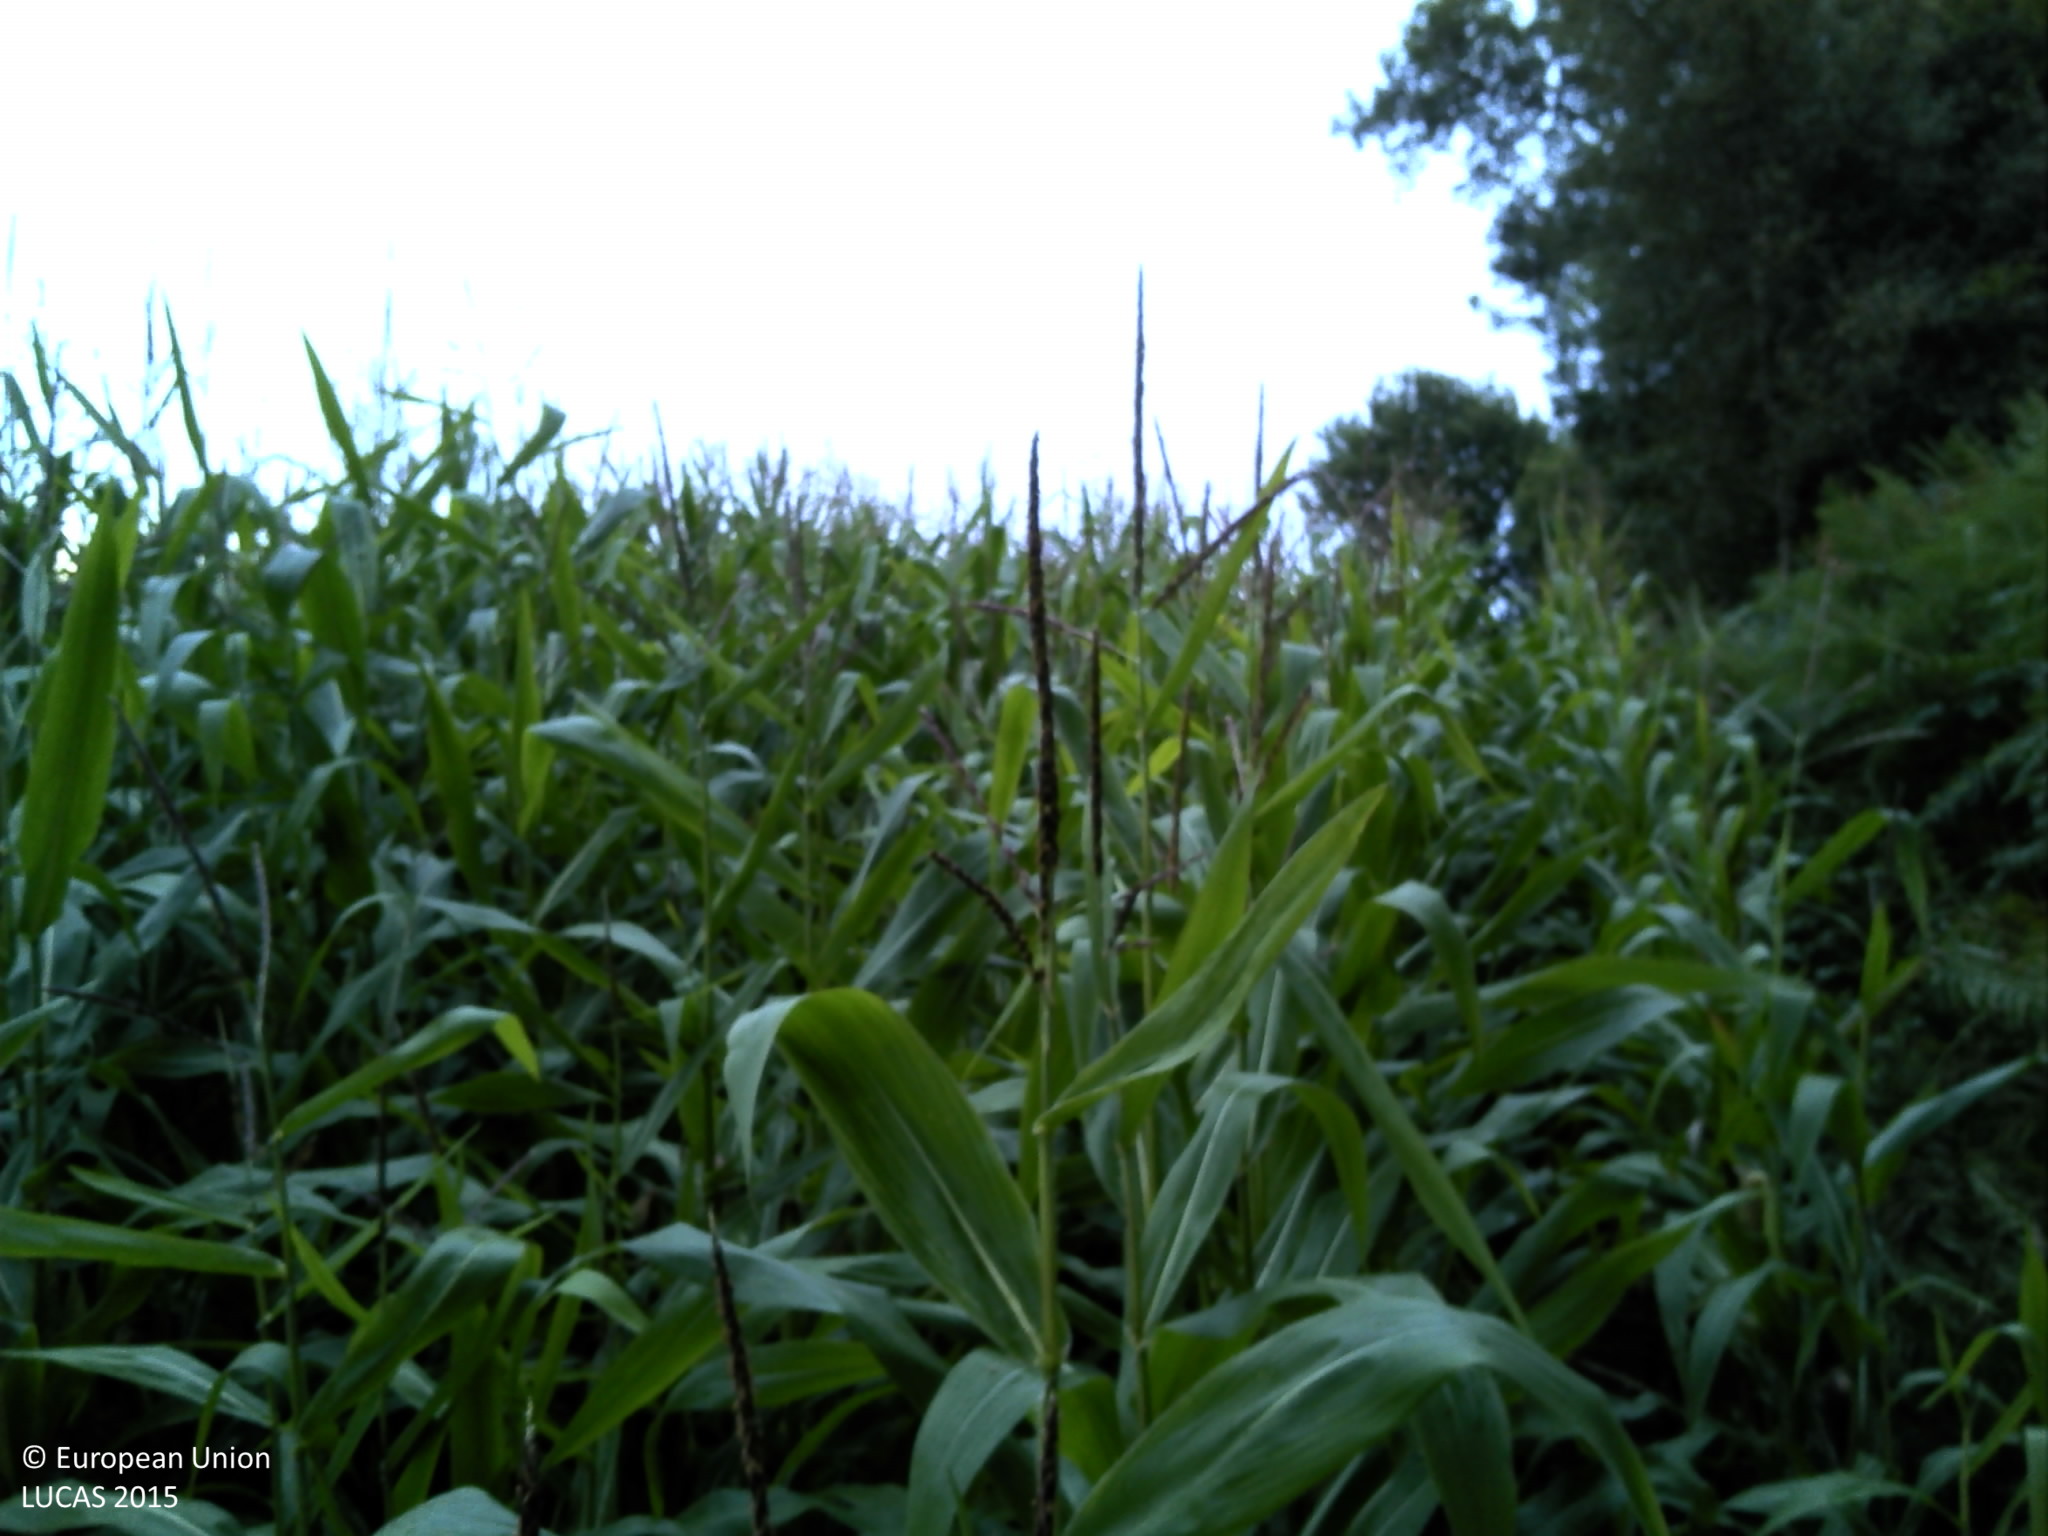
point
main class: Cropland
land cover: Maize
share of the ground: > 75 %
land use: Agriculture (excluding fallow land and kitchen gardens)
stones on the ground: < 10 %
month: September
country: FR
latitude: 48.5430
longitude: -3.7510
